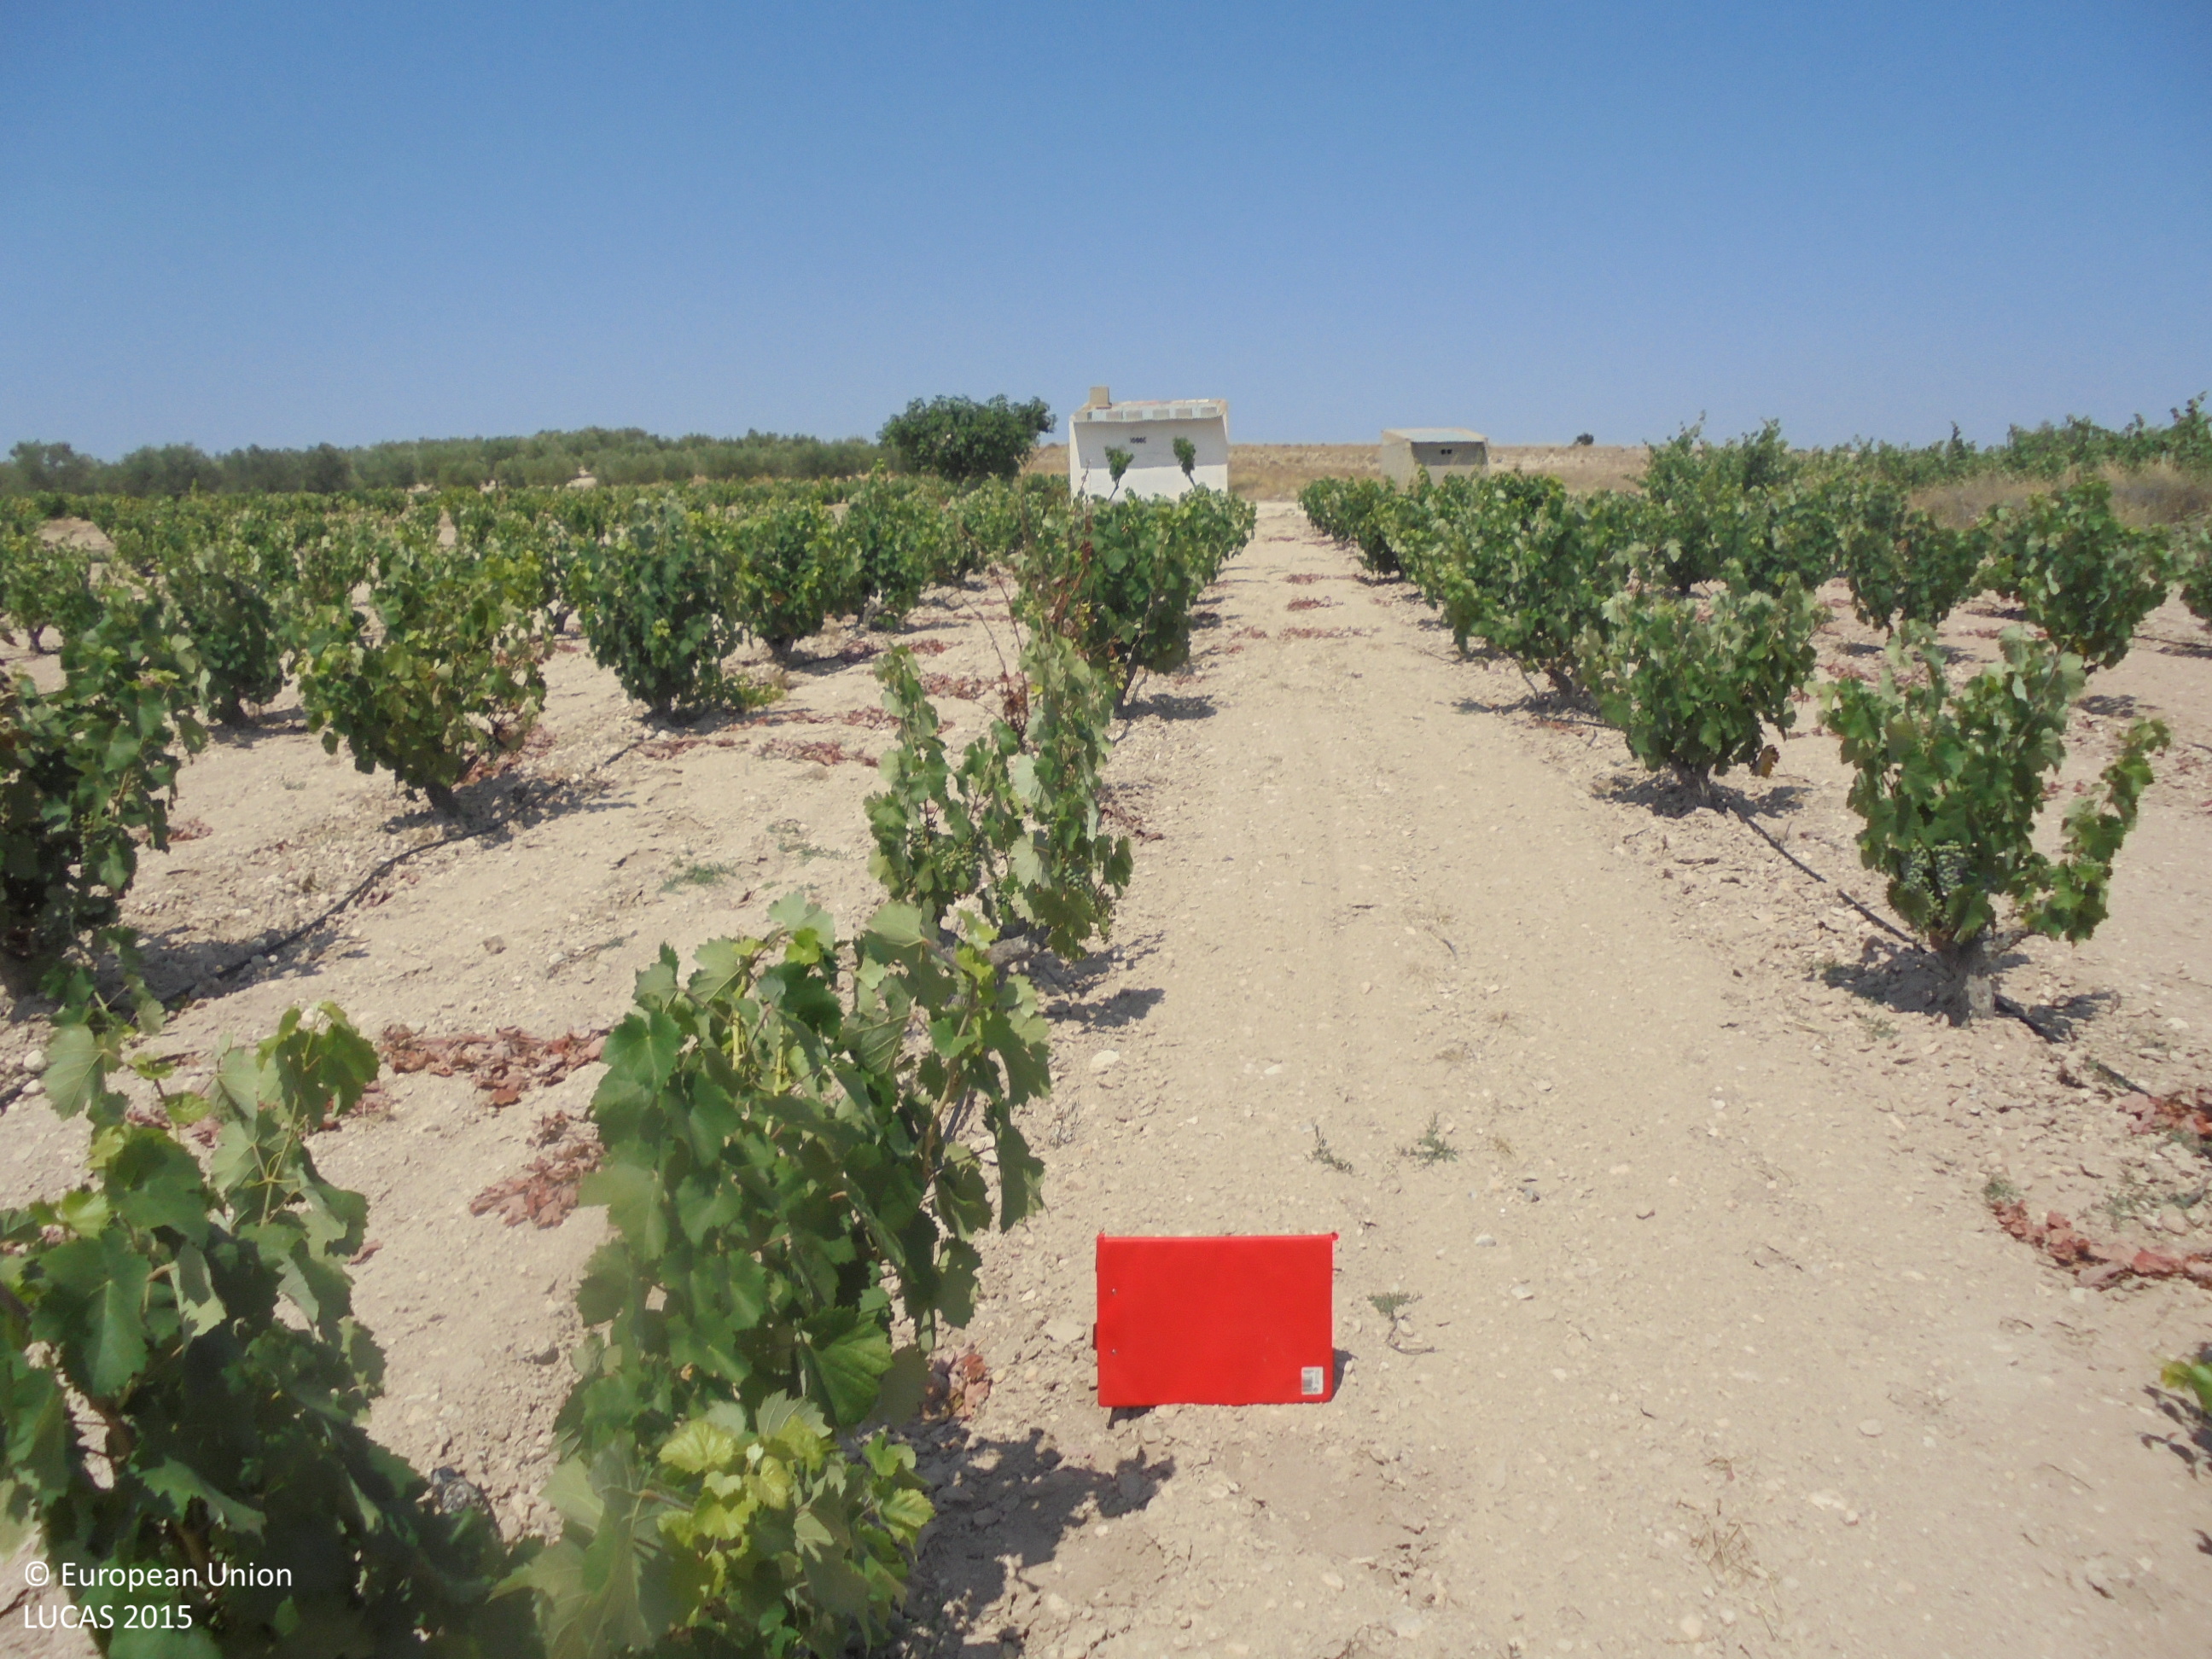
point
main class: Cropland
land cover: Vineyards
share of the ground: 10 - 25 %
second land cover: Other bare soil
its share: > 75 %
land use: Agriculture (excluding fallow land and kitchen gardens)
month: July
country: ES
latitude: 38.5858
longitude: -1.4845
